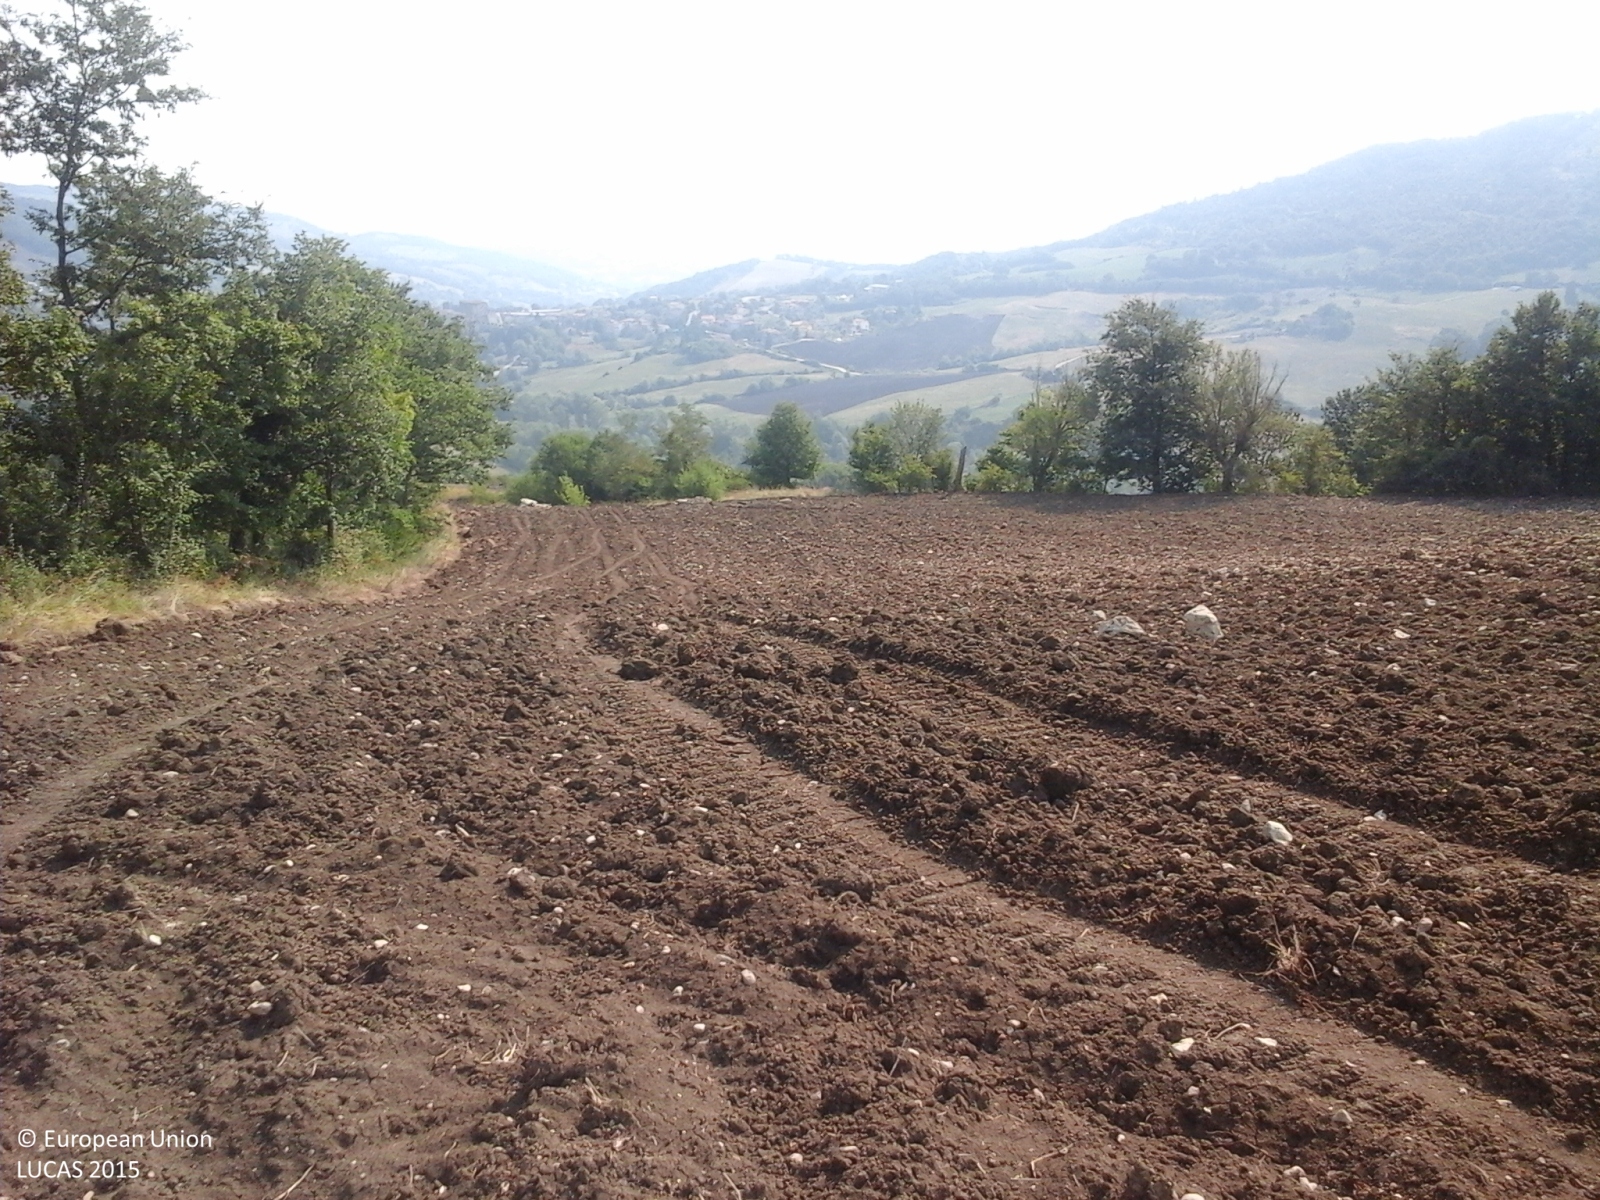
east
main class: Cropland
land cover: Oats
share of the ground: > 75 %
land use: Agriculture (excluding fallow land and kitchen gardens)
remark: Harvested field
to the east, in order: Oats; Broadleaved woodland; Oats
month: August
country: IT
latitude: 43.8357
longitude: 12.3944
